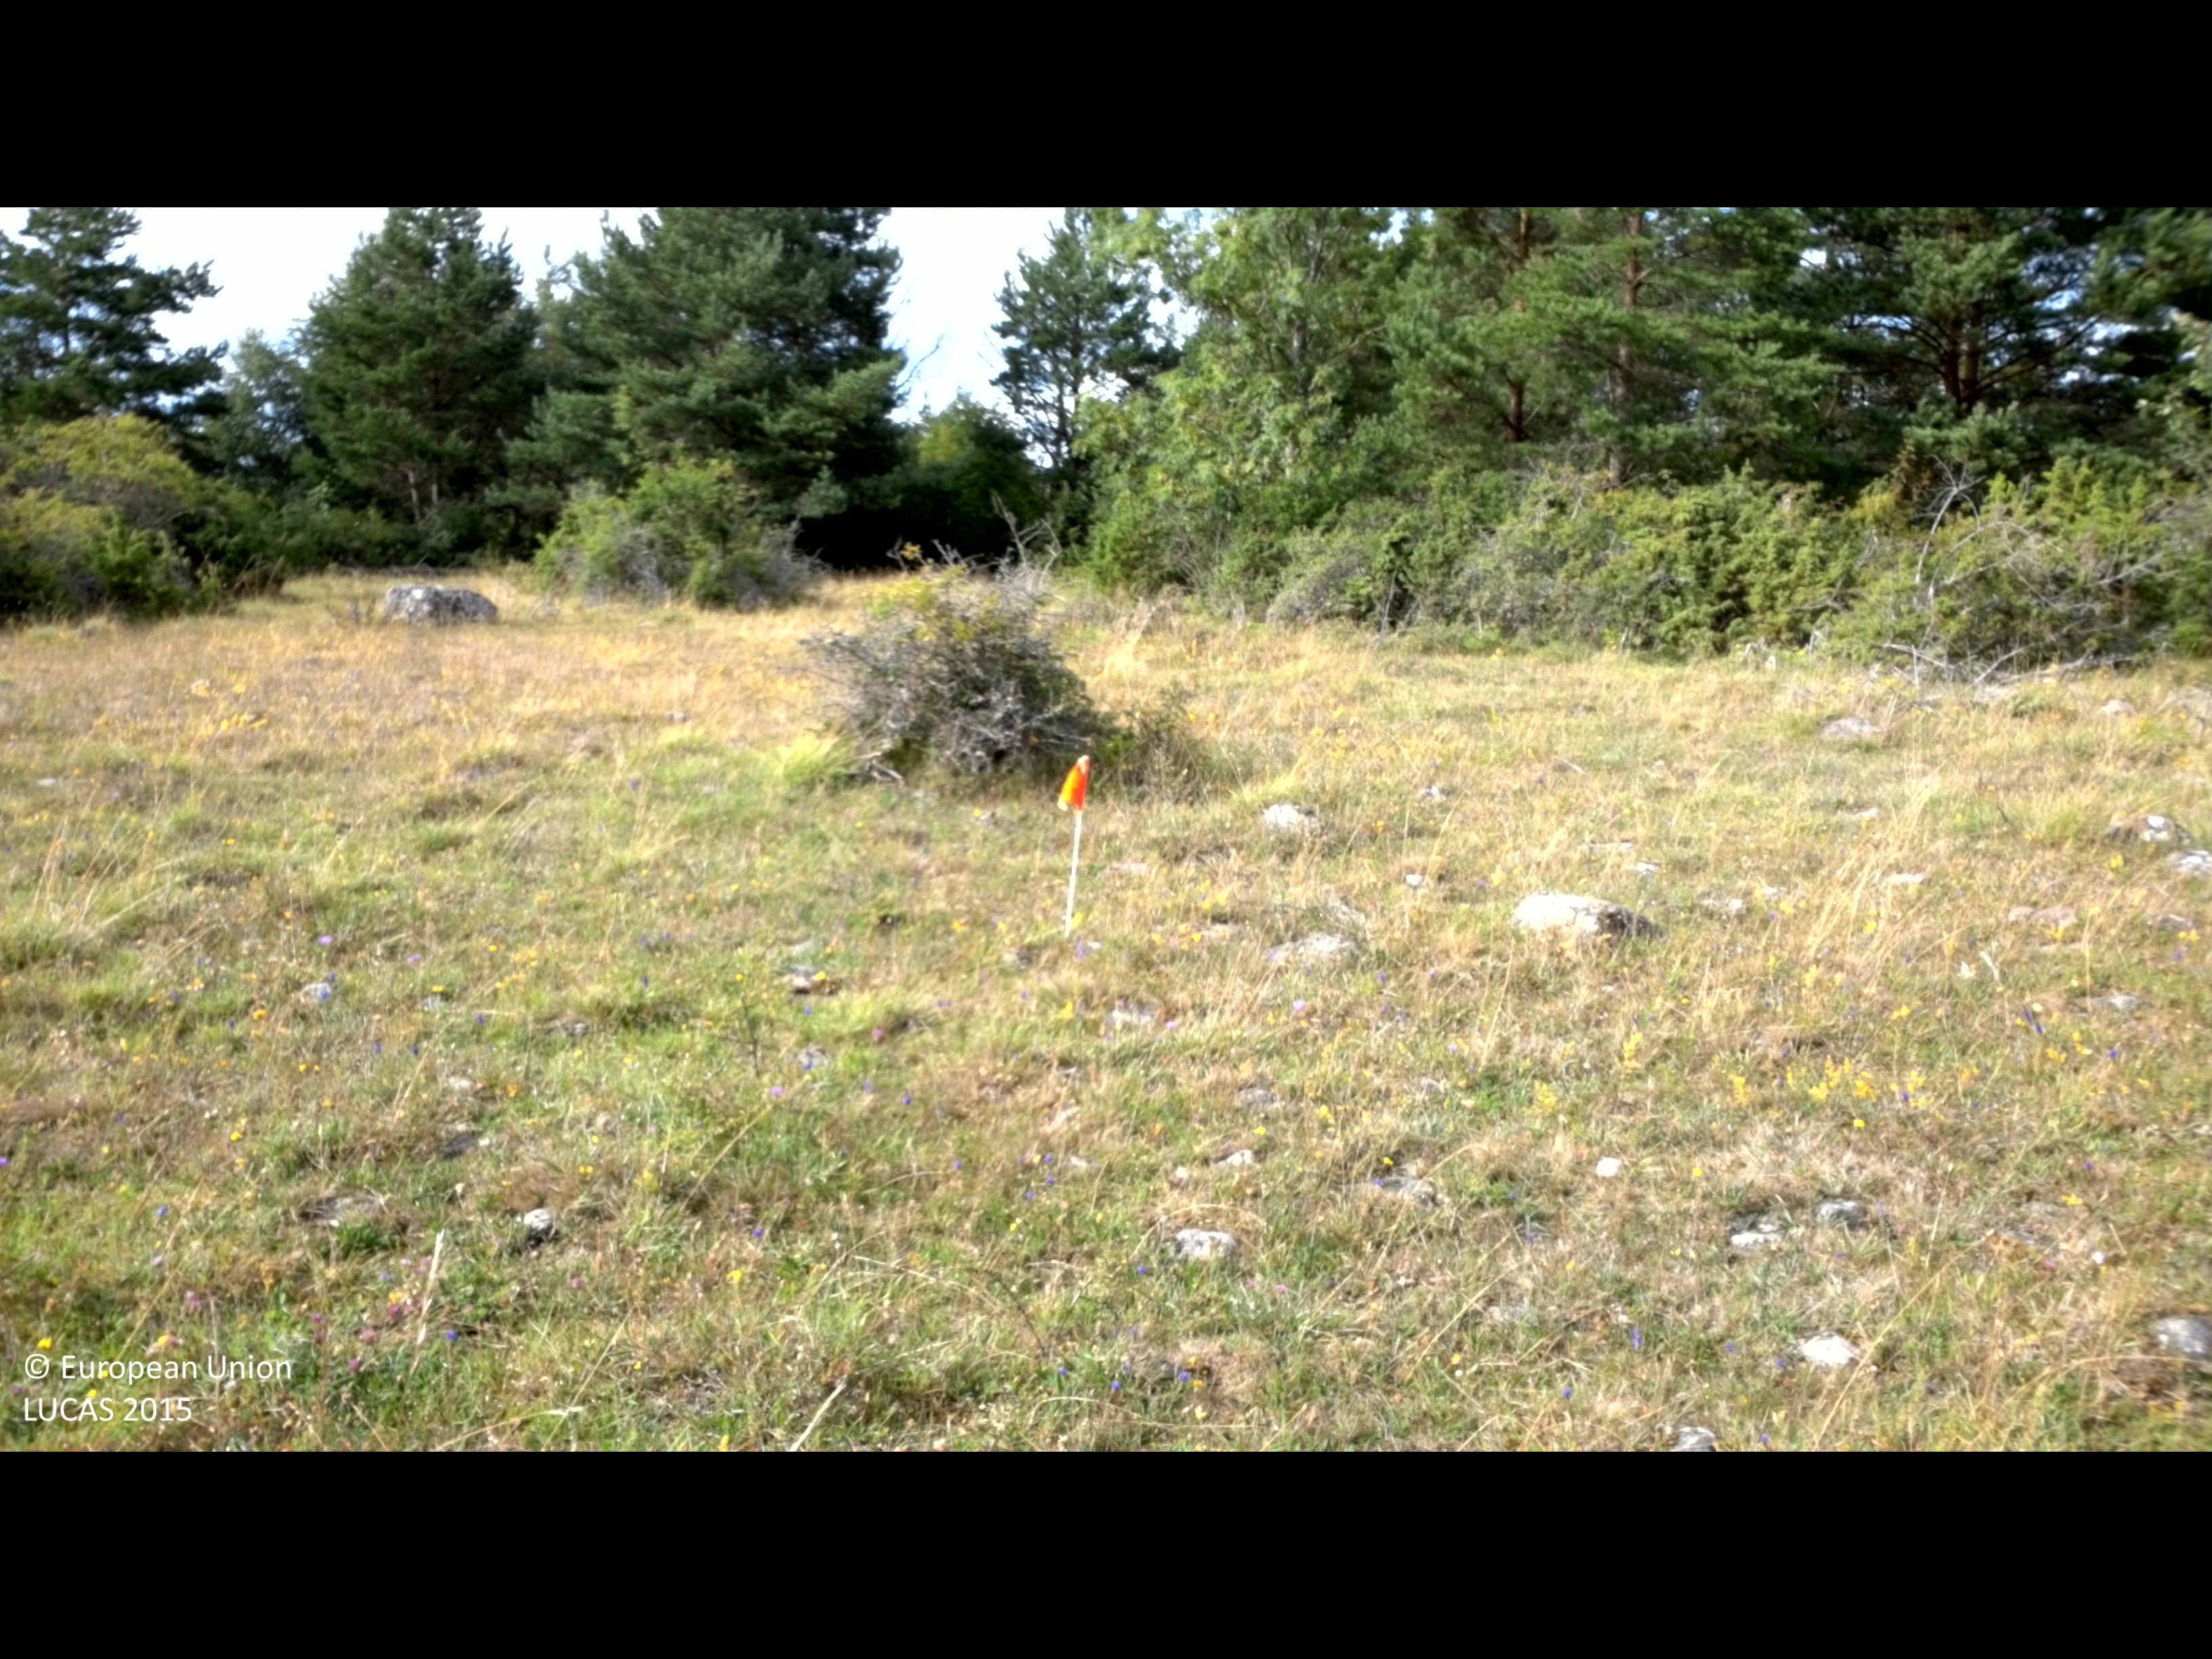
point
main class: Grassland
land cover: Grassland without tree/shrub cover
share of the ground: > 75 %
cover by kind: herbaceous plants 95 %, shrubs 5 %
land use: Agriculture (excluding fallow land and kitchen gardens)
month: July
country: SE
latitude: 57.1738
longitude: 16.9318
